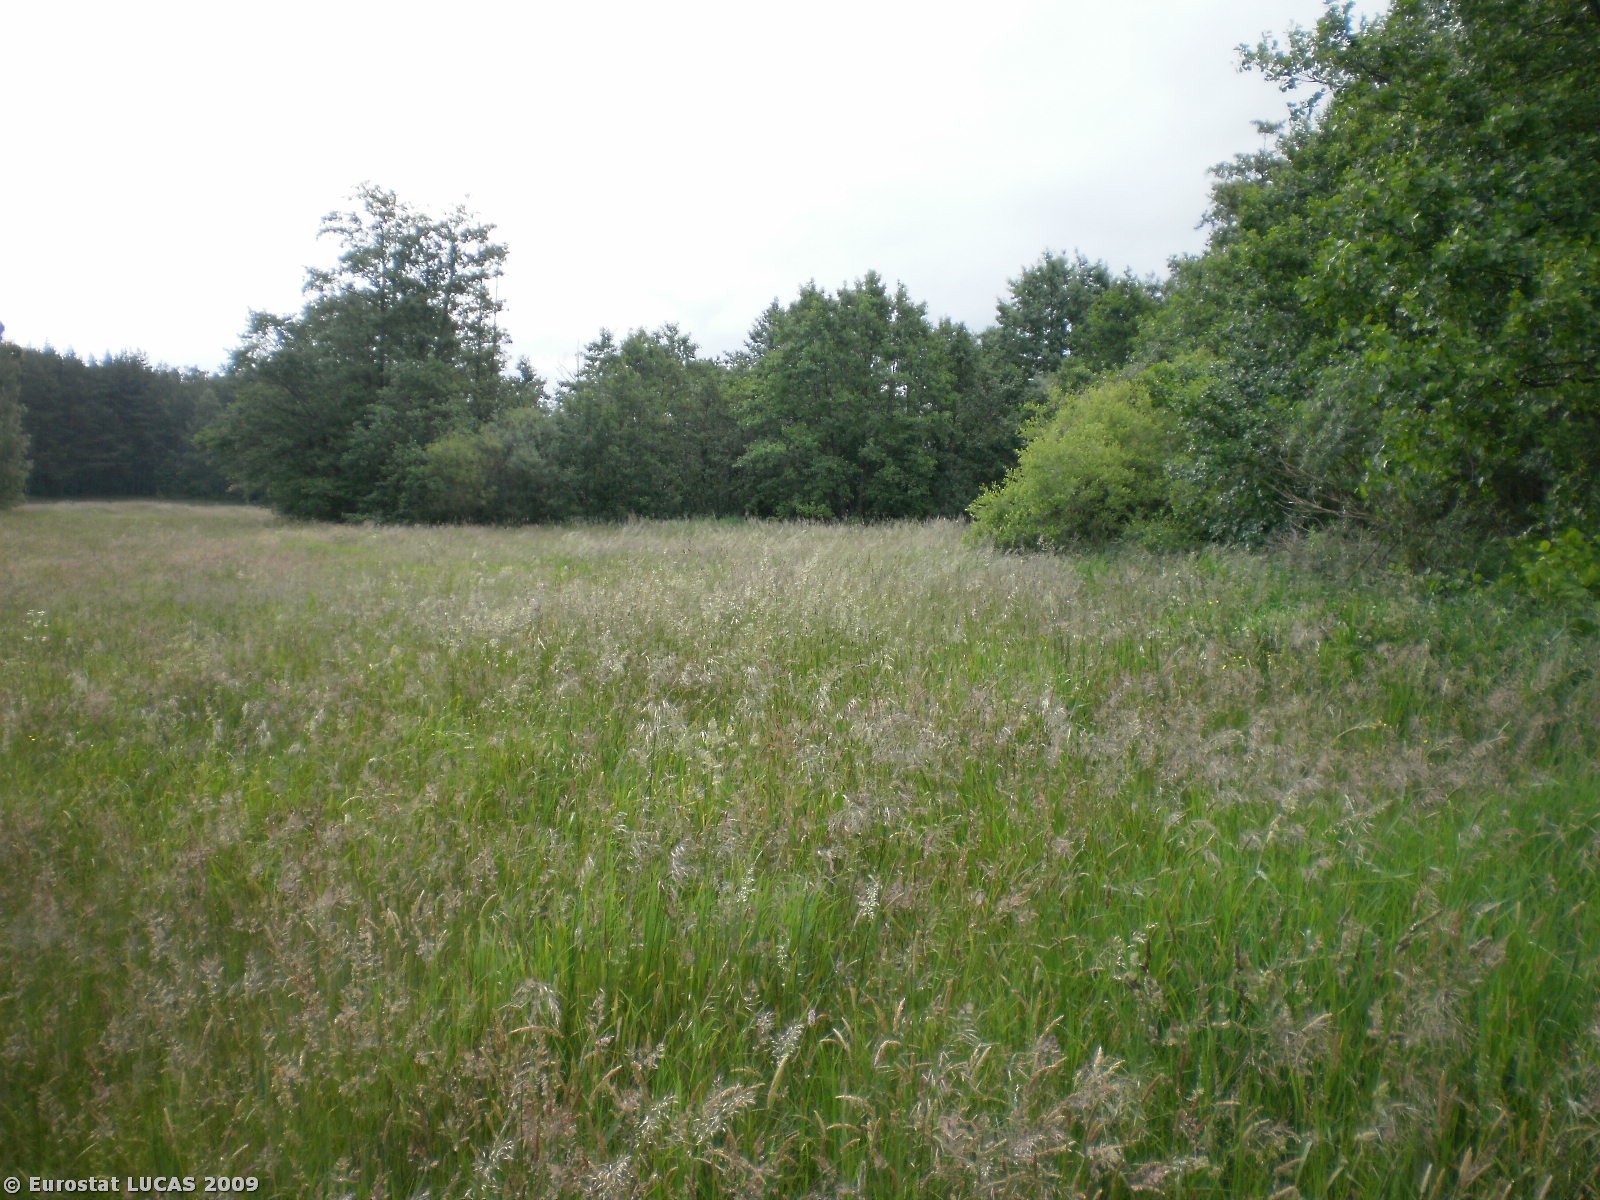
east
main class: Grassland
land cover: Grassland without tree/shrub cover
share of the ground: > 75 %
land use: Agriculture (excluding fallow land and kitchen gardens)
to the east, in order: Grassland without tree/shrub cover; Shrubland with sparse tree cover; Inland marshes; Shrubland with sparse tree cover; Grassland without tree/shrub cover; Fences; Grassland without tree/shrub cover; Fences; Grassland without tree/shrub cover; Inland marshes; Grassland without tree/shrub cover
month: June
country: PL
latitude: 54.5896
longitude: 17.8895
